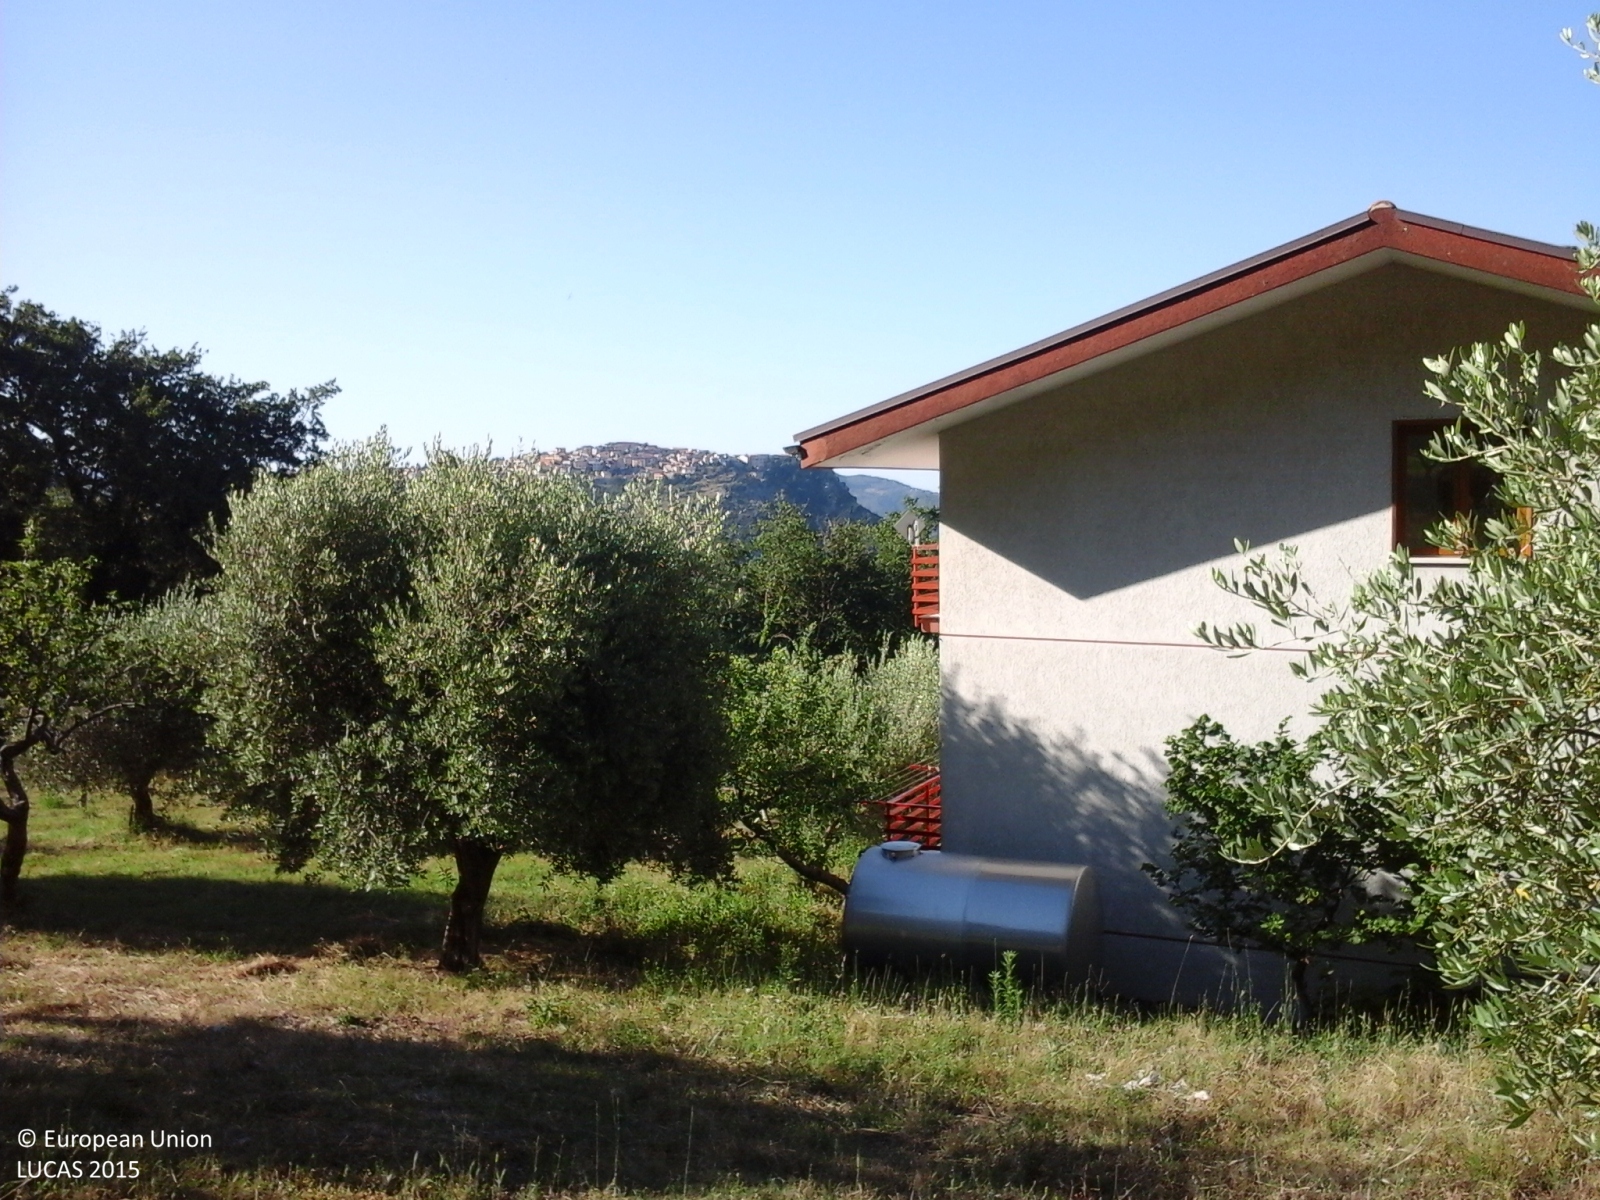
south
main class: Woodland
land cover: Broadleaved woodland
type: thermophilous deciduous forest
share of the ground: > 75 %
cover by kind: broadleaved forest trees 100 %
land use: Forestry
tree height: > 5 m
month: June
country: IT
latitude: 40.4245
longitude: 15.1053
